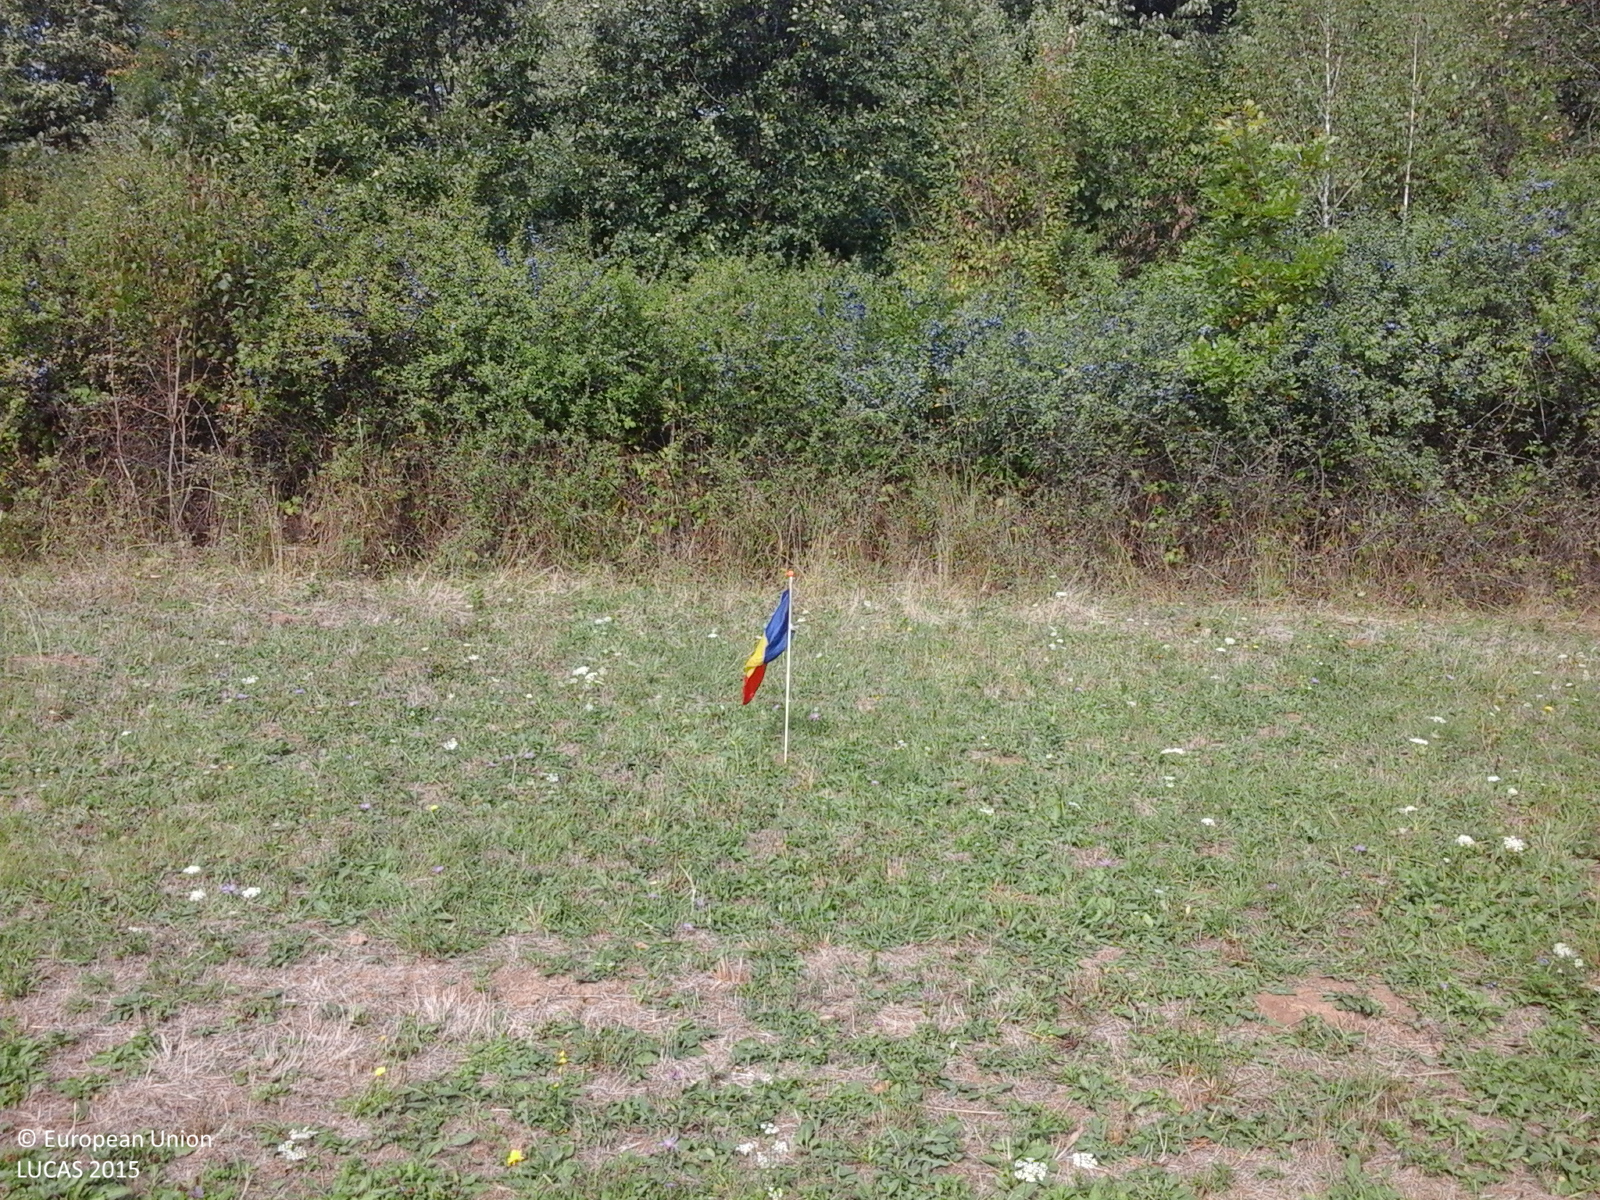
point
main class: Grassland
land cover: Grassland without tree/shrub cover
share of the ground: > 75 %
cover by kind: herbaceous plants 100 %
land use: Agriculture (excluding fallow land and kitchen gardens)
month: September
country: RO
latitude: 45.5203
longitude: 22.0607
